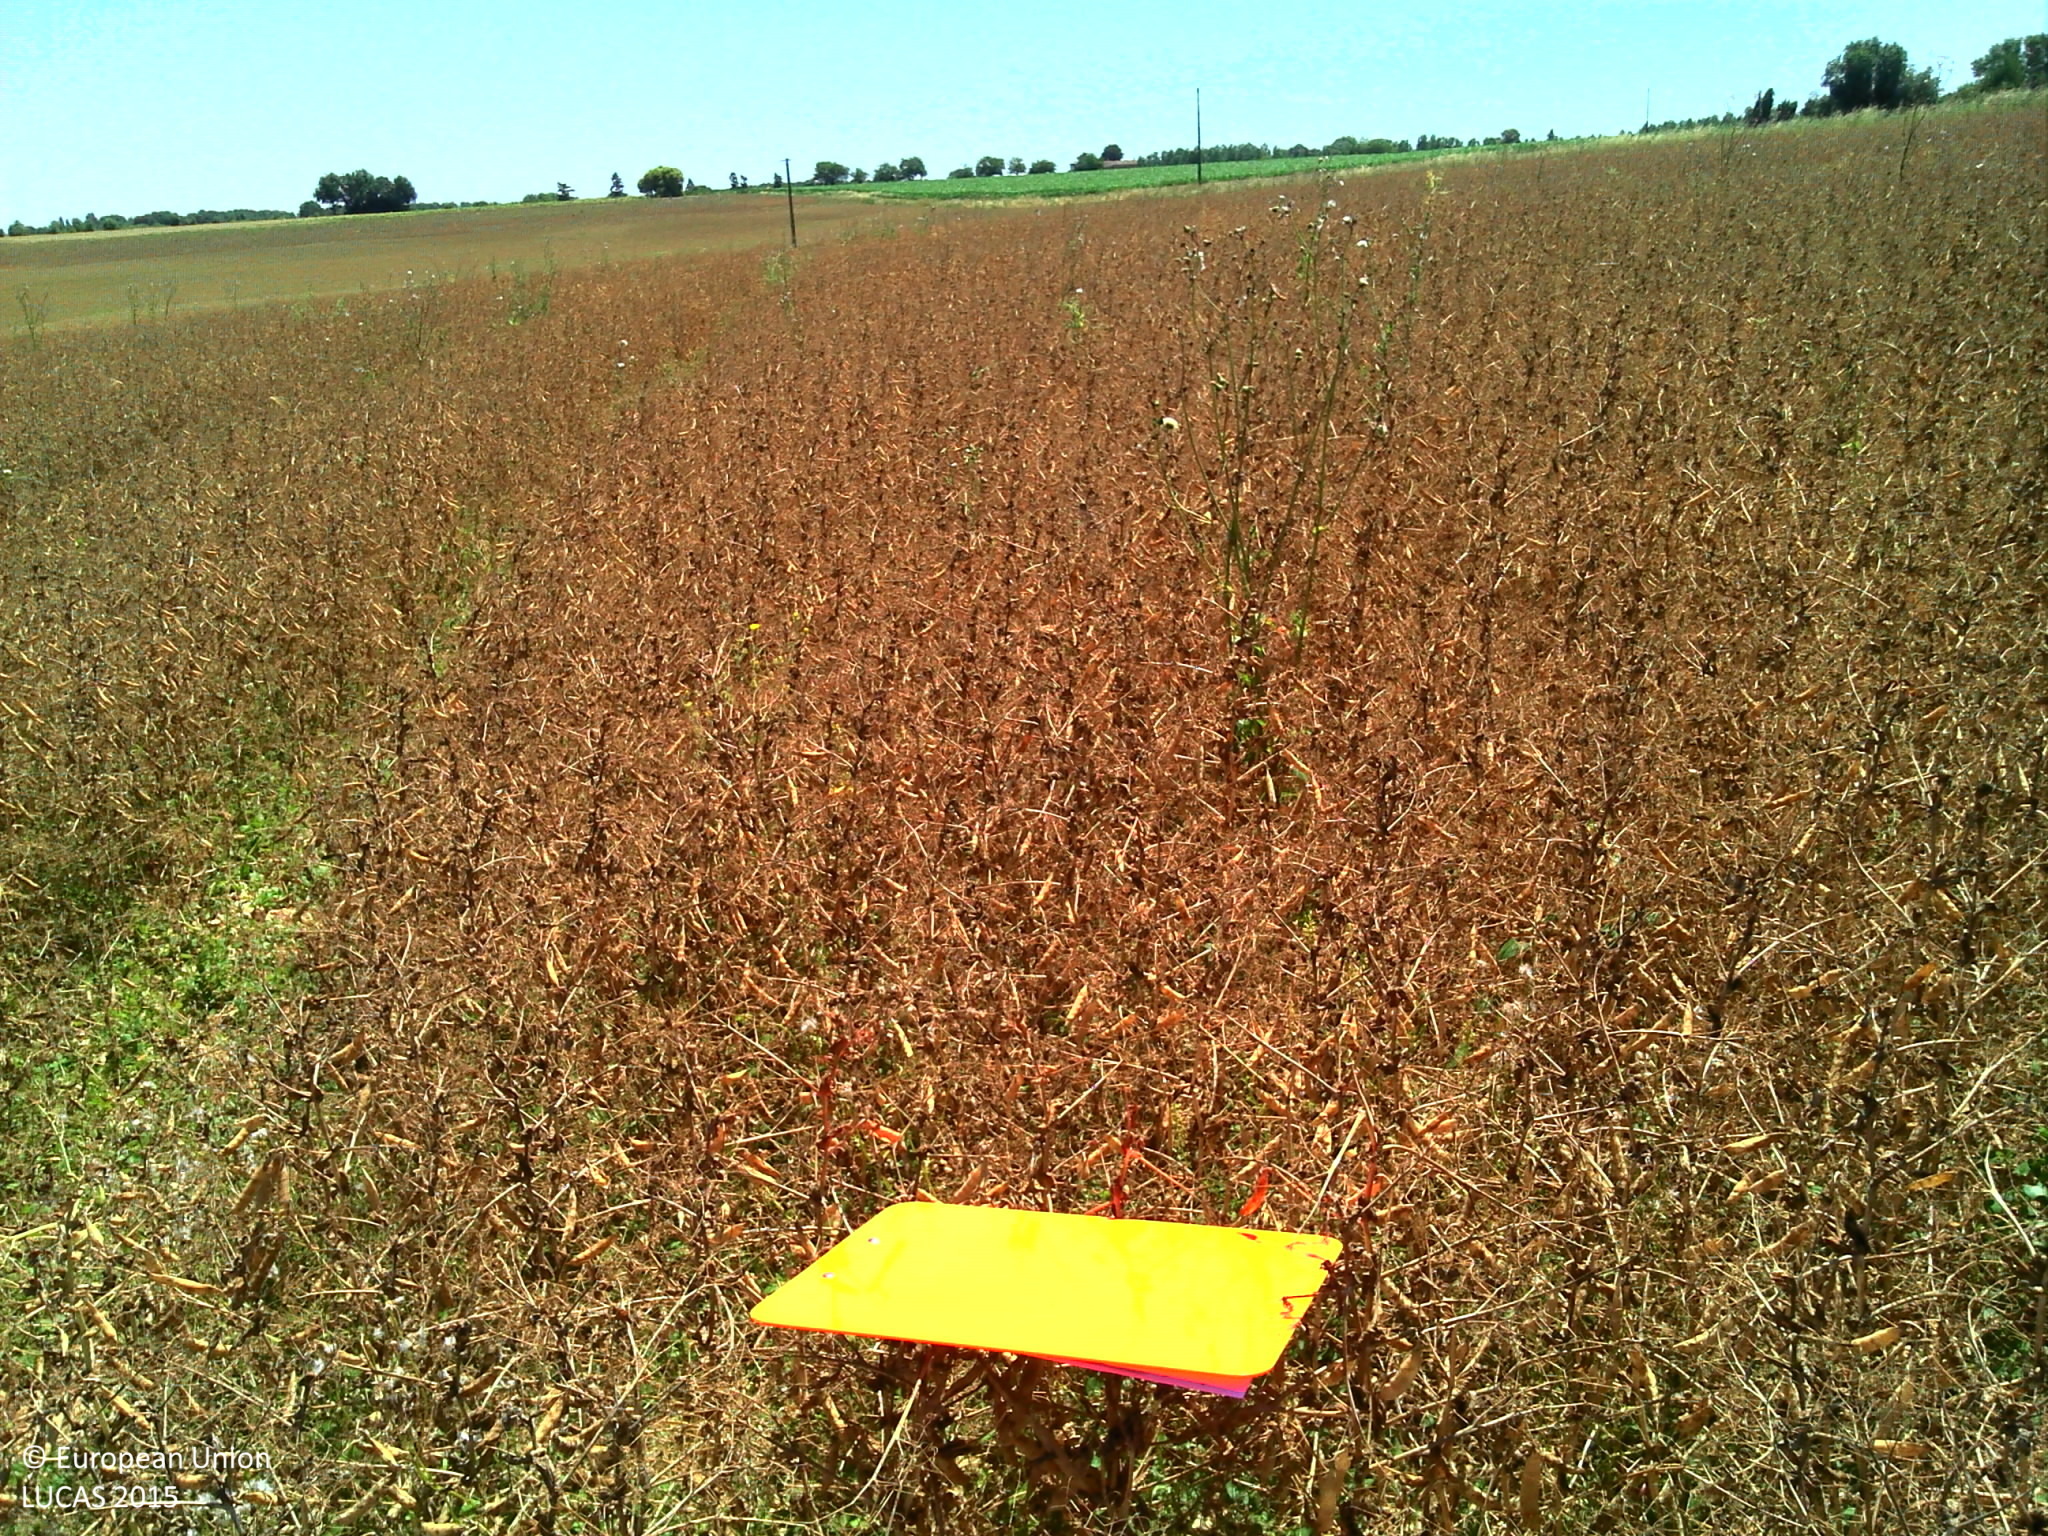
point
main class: Cropland
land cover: Dry pulses
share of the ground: > 75 %
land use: Agriculture (excluding fallow land and kitchen gardens)
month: June
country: FR
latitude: 45.8517
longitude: -0.6753
